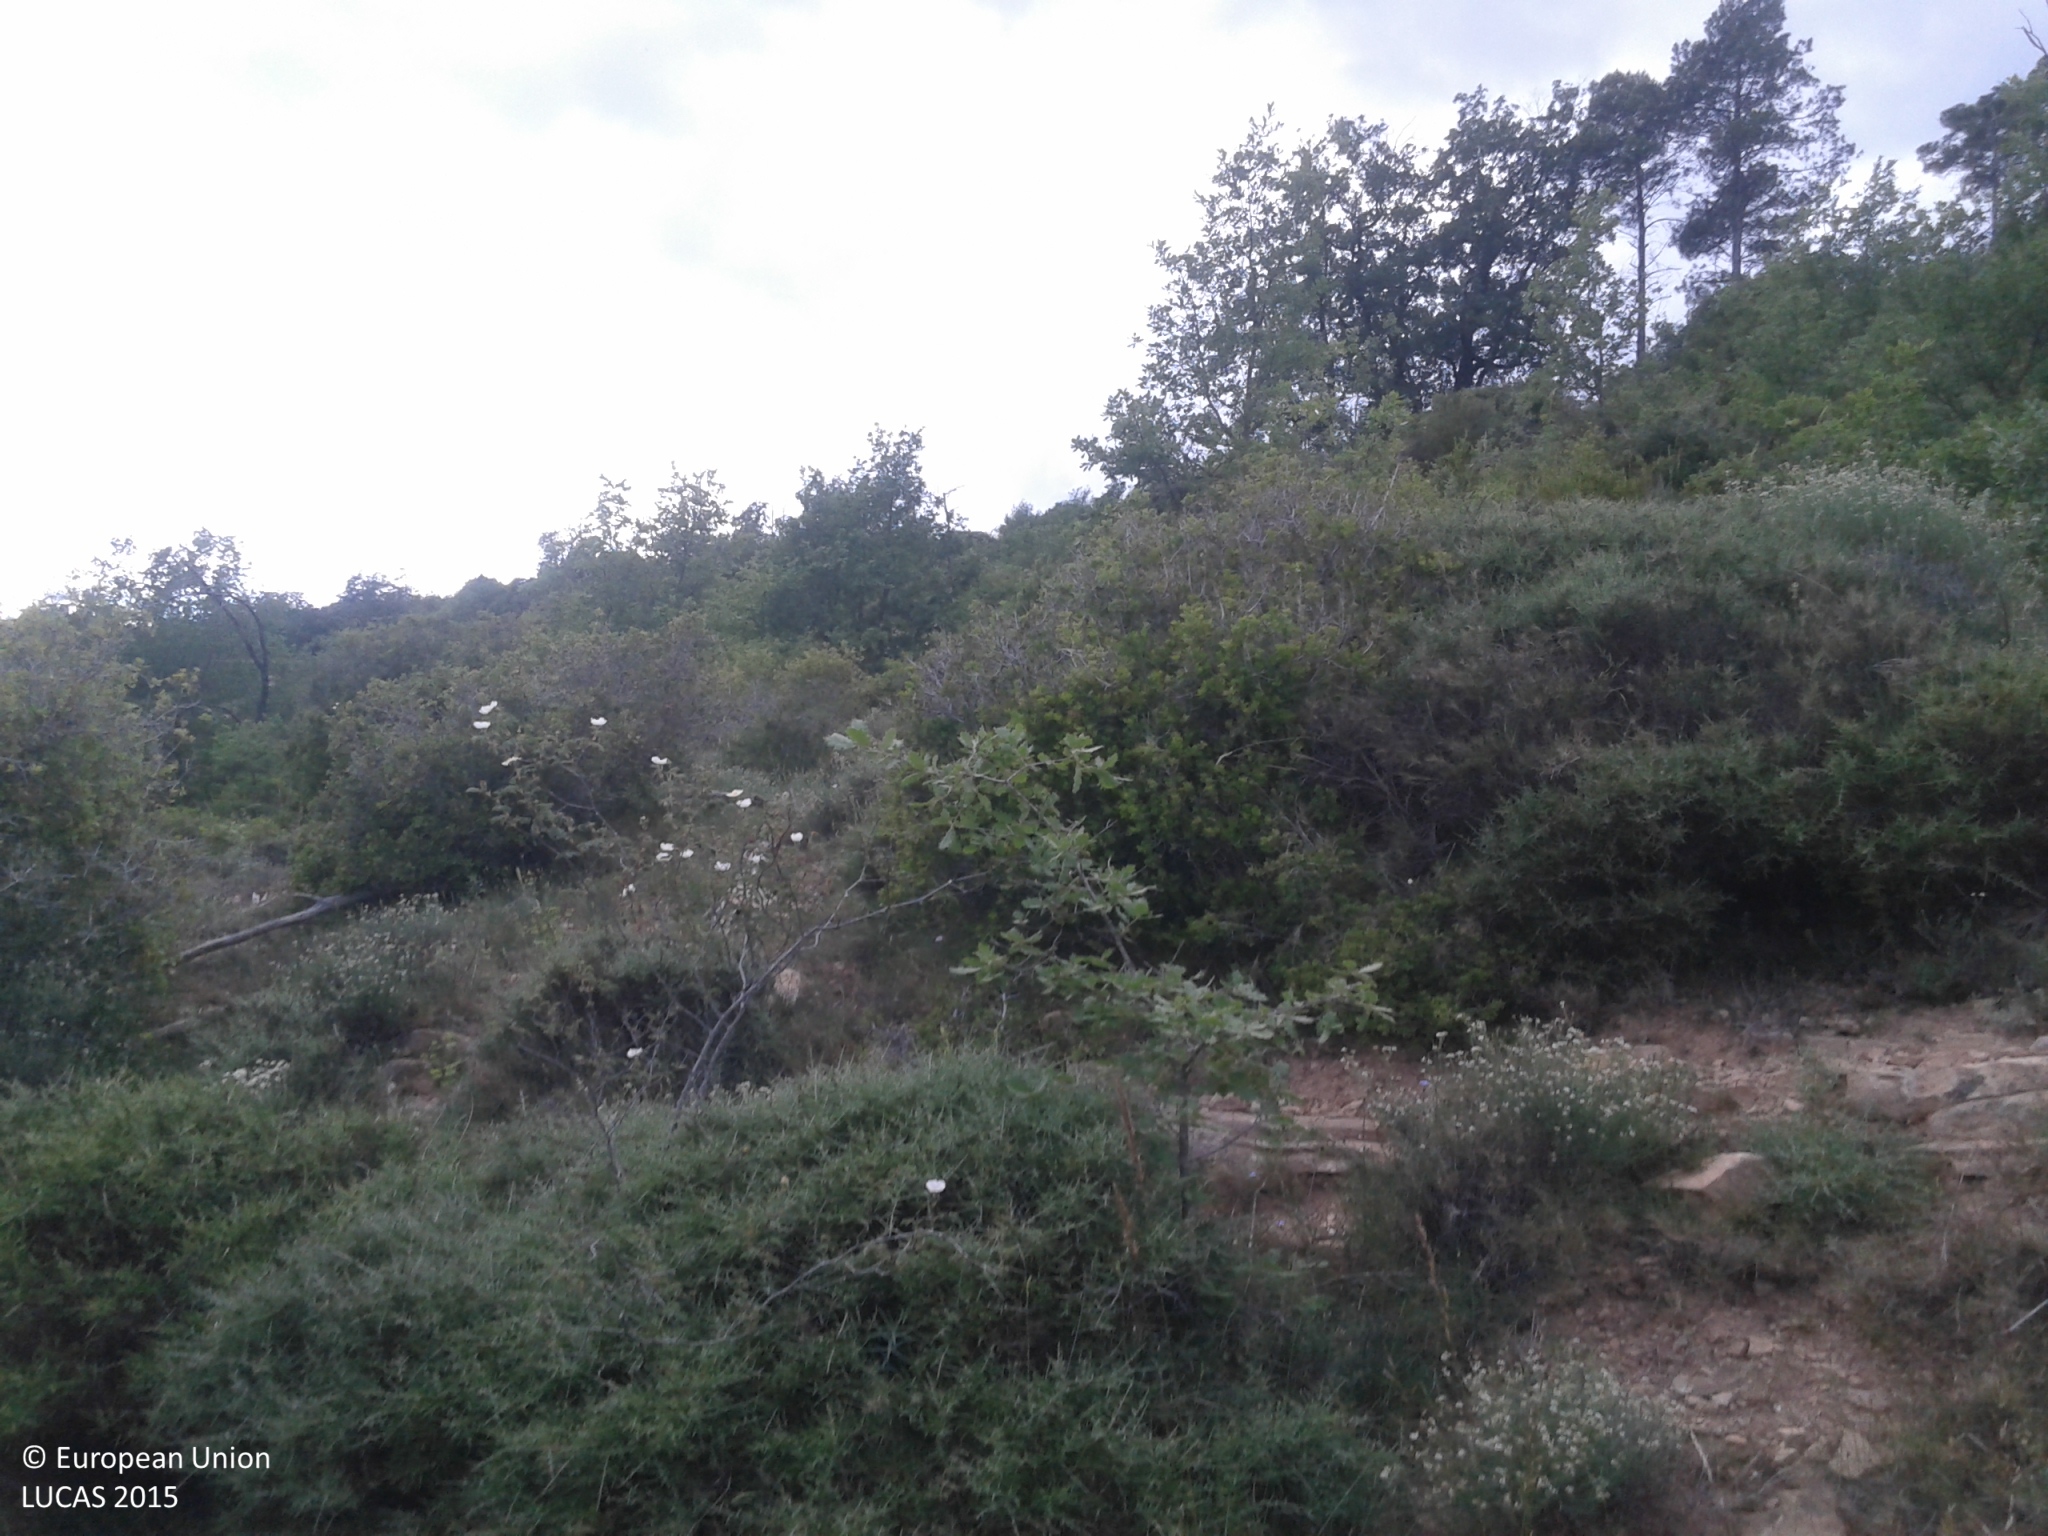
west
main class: Shrubland
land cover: Shrubland with sparse tree cover
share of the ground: > 75 %
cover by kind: shrubs 80 %, herbaceous plants 10 %, broadleaved forest trees 5 %, consolidated bare surface 5 %
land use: Agriculture (excluding fallow land and kitchen gardens)
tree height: < 5 m
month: May
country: ES
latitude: 41.8663
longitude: 1.5682
